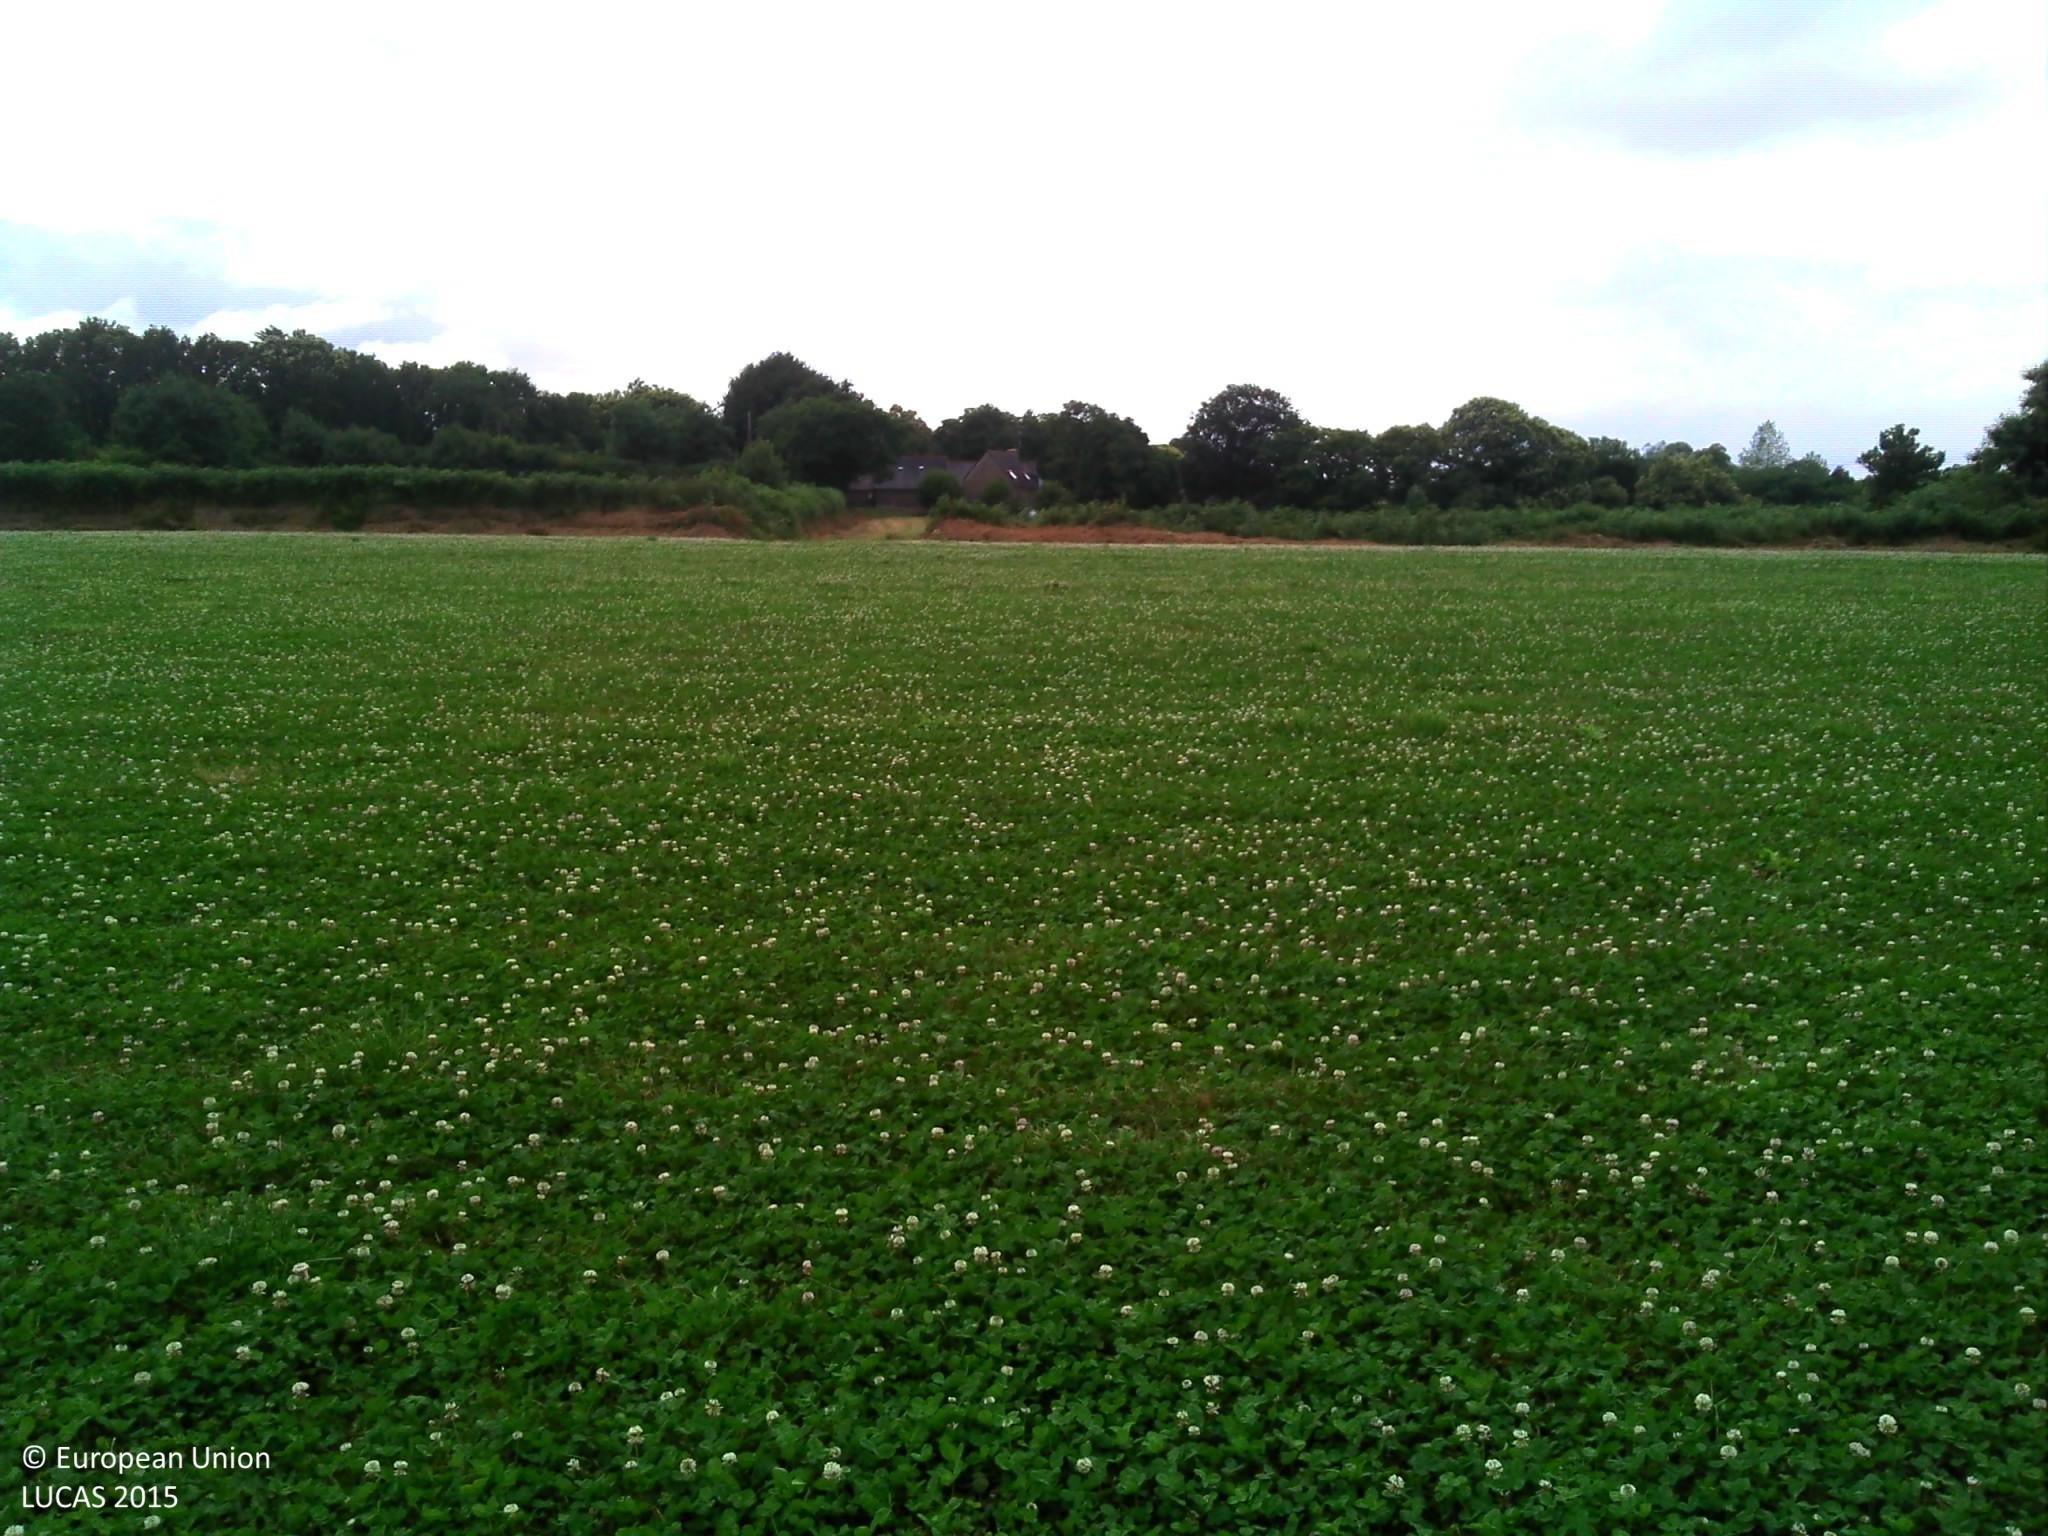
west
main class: Cropland
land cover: Clovers
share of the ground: > 75 %
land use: Agriculture (excluding fallow land and kitchen gardens)
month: July
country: FR
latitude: 48.6532
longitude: -3.4497
